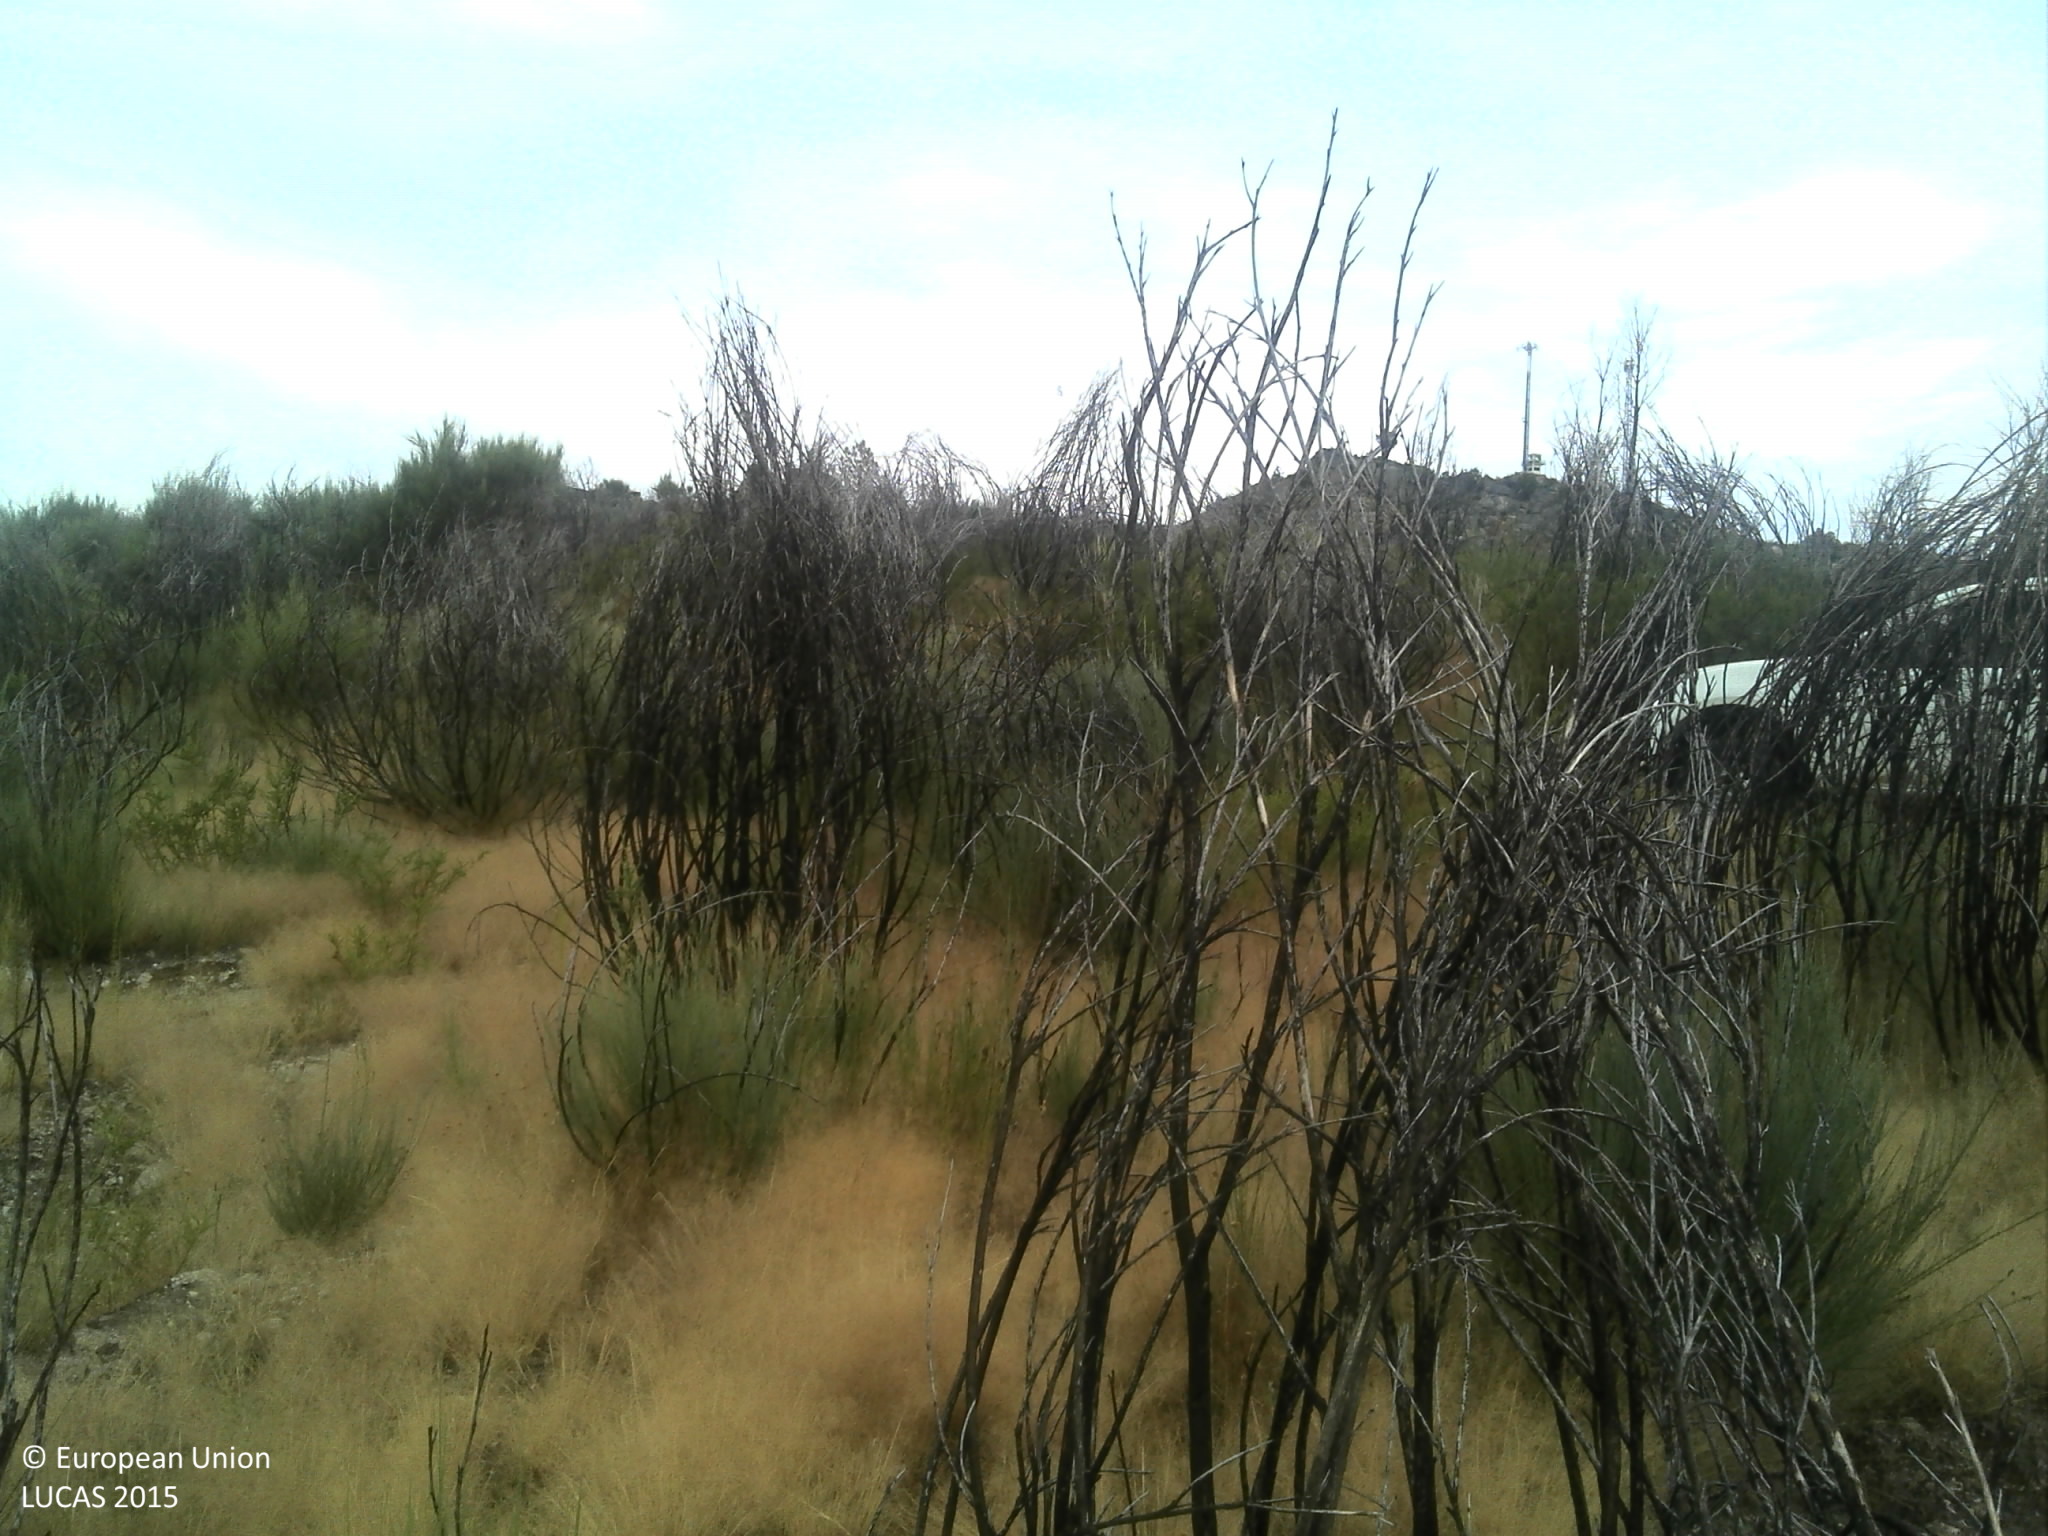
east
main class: Shrubland
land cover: Shrubland without tree cover
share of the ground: 50 - 75 %
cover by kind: shrubs 75 %, herbaceous plants 20 %, unconsolidated bare surface 5 %
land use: Semi-natural and natural areas not in use
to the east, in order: Shrubland without tree cover; Tracks; Shrubland without tree cover; Rock outcrops; Shrubland without tree cover; Dry stone walls; Shrubland without tree cover; Shrubland with sparse tree cover; Shrubland without tree cover
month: July
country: PT
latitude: 41.3765
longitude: -7.6950
